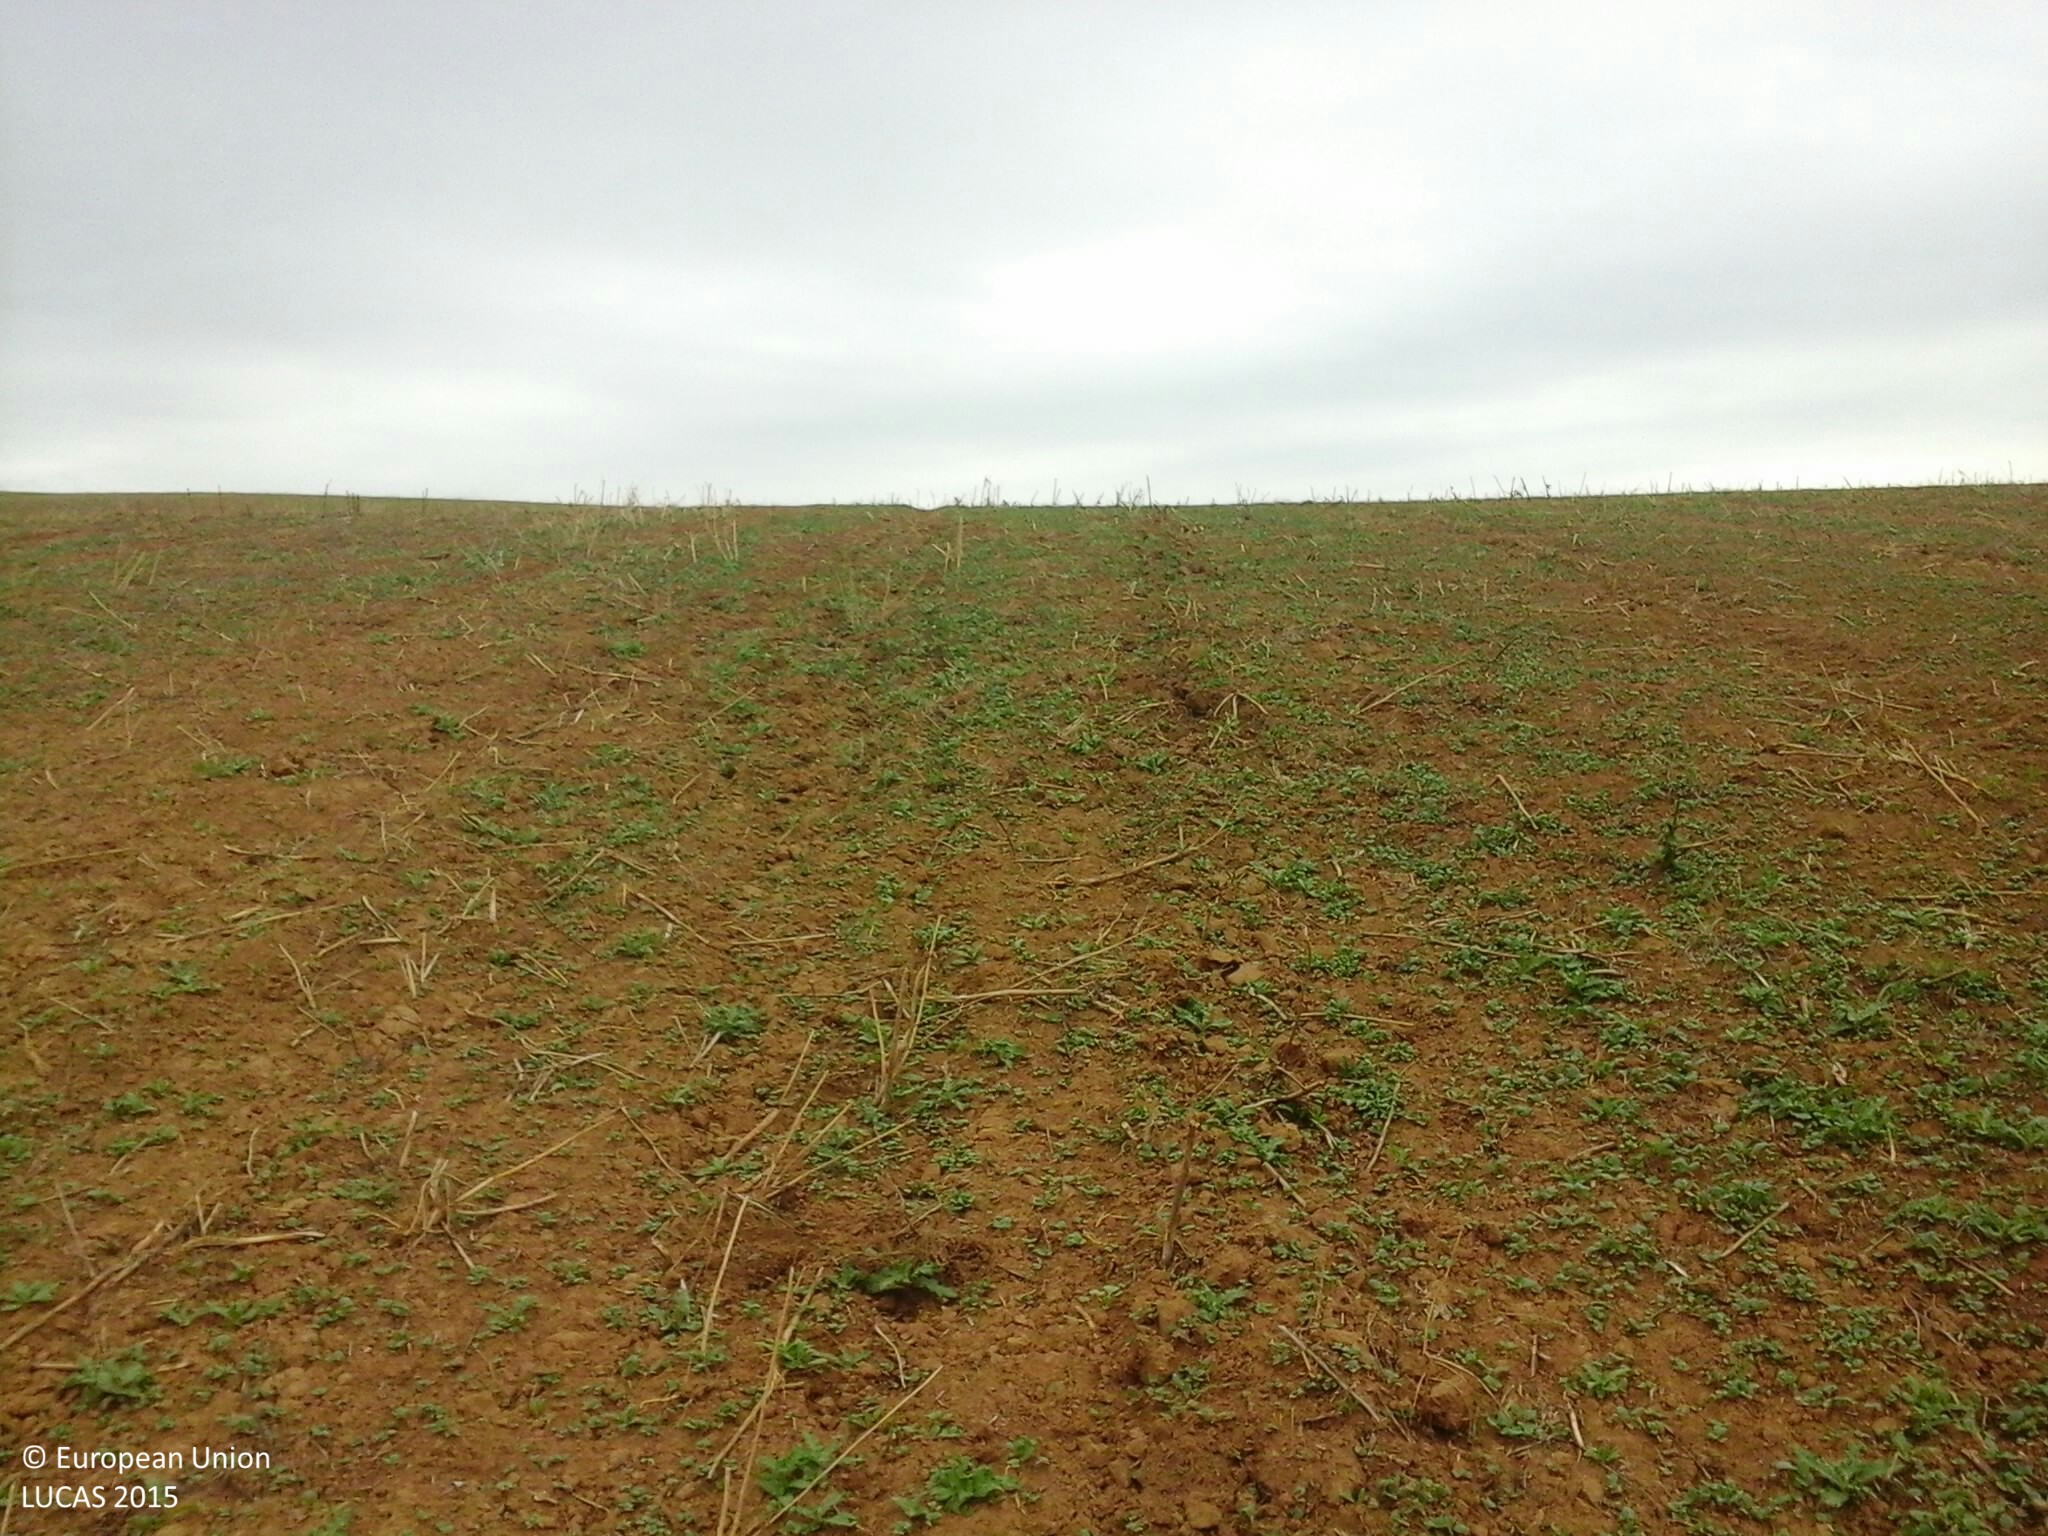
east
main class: Cropland
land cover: Rape and turnip rape
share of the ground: < 10 %
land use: Agriculture (excluding fallow land and kitchen gardens)
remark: Harvested field
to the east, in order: Rape and turnip rape
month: July
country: HU
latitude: 46.7302
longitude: 17.8719
